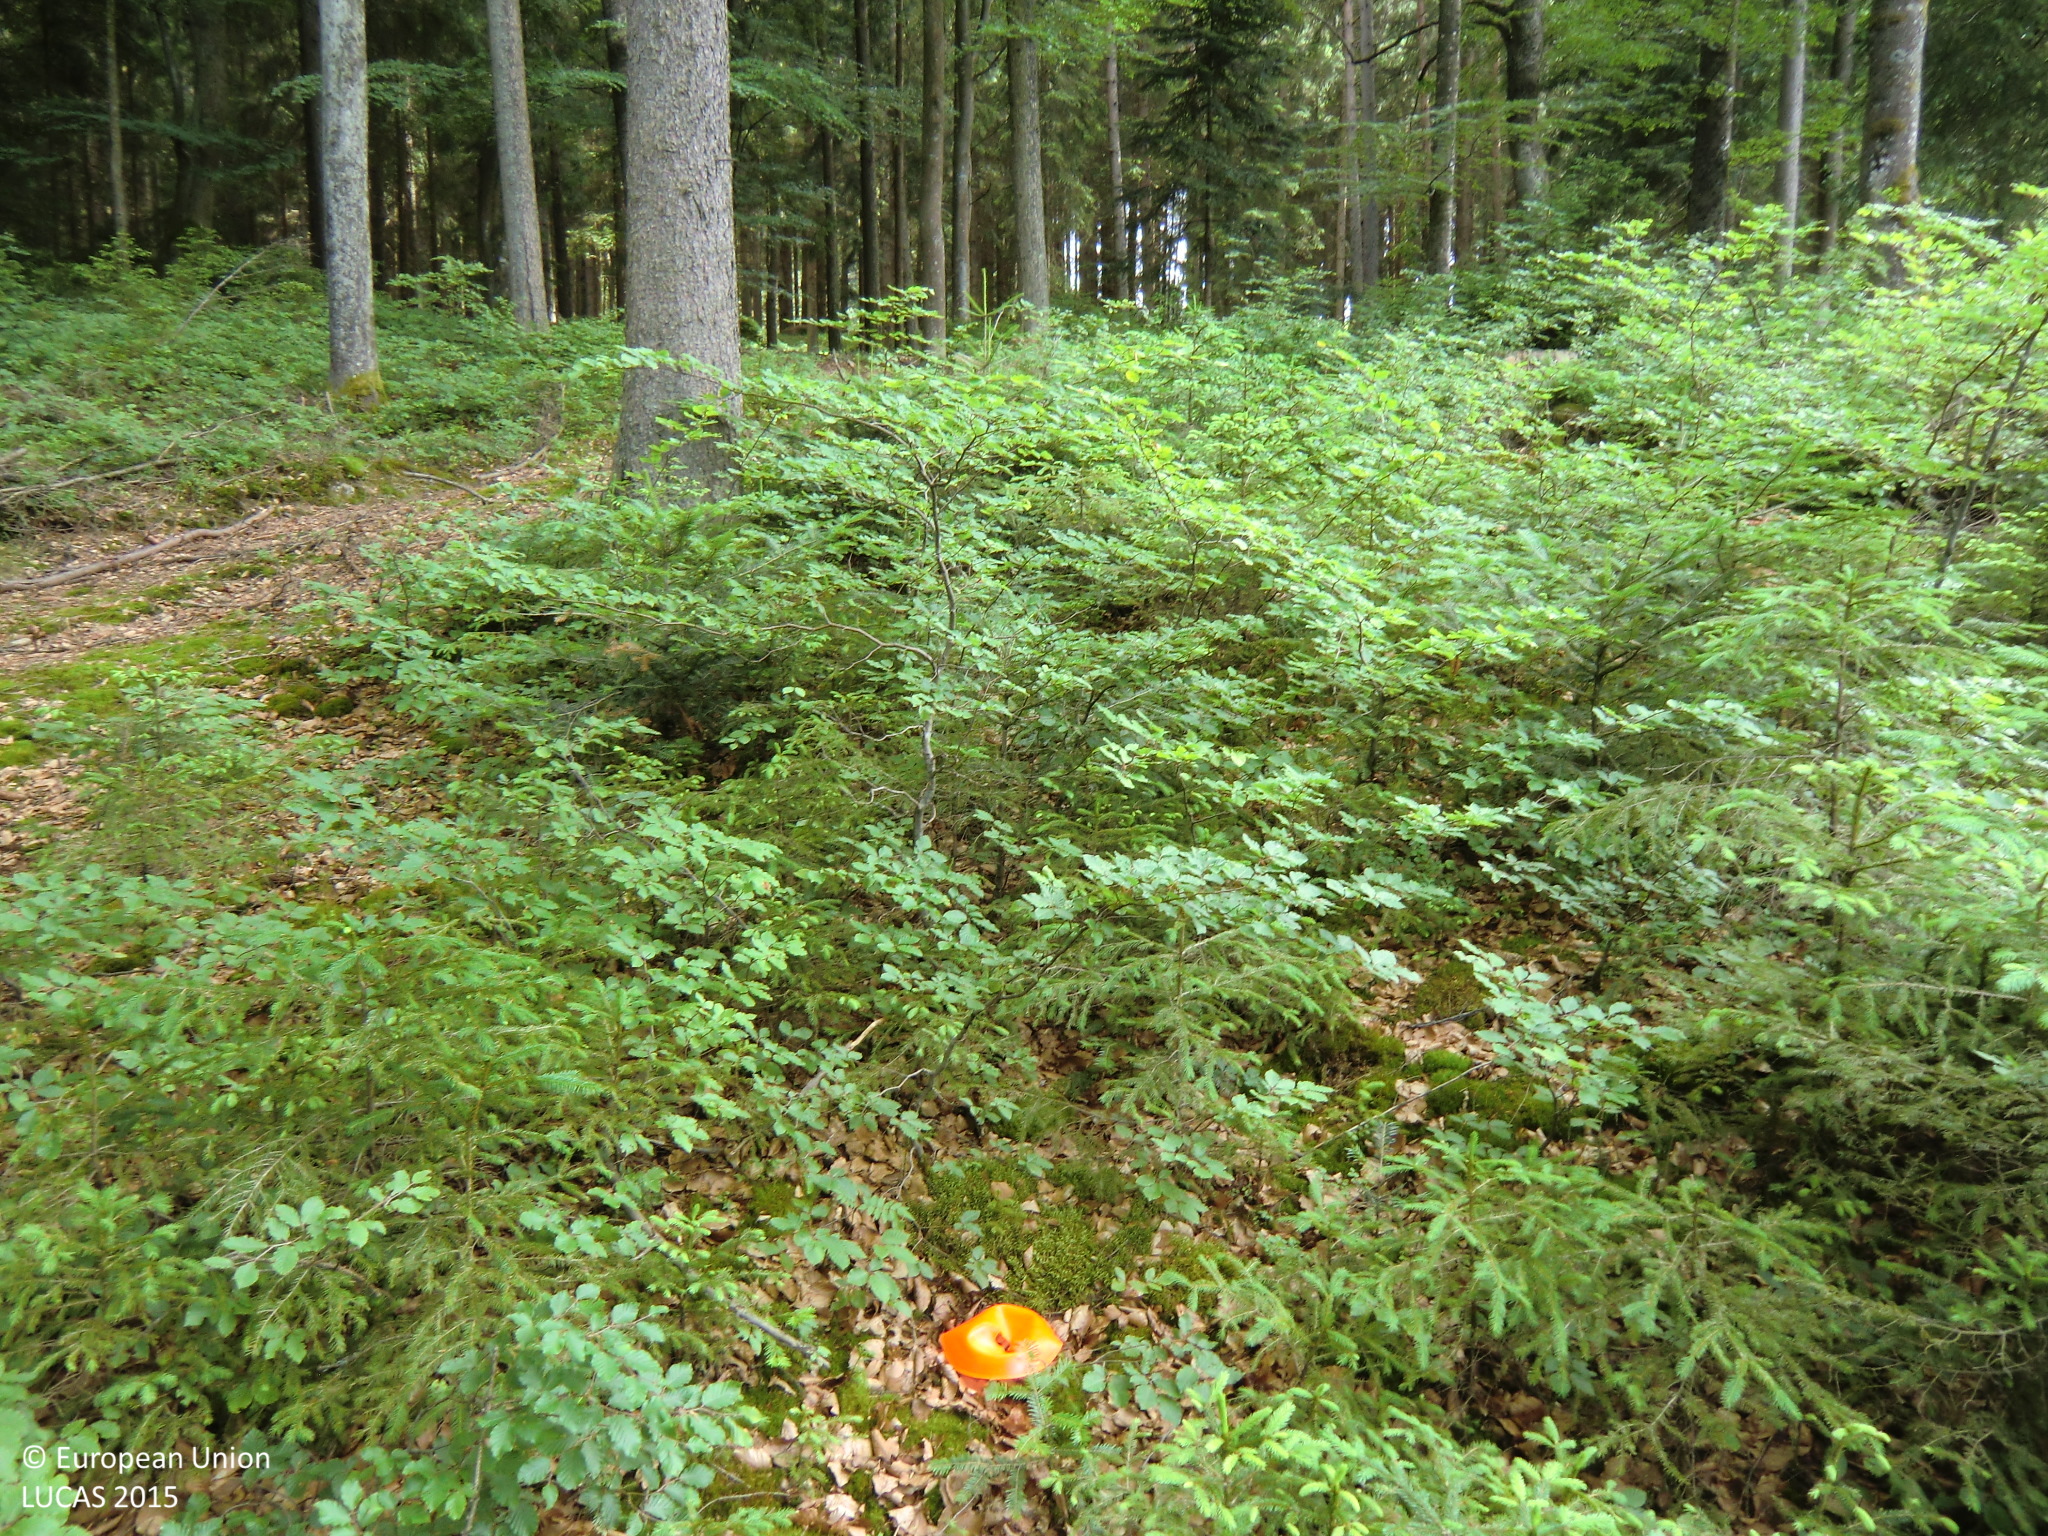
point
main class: Woodland
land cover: Spruce dominated mixed woodland
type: hemiboreal forest and nemoral coniferous forest and mixed broadleaved-coniferous forest
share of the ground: > 75 %
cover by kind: coniferous forest trees 45 %, broadleaved forest trees 45 %, herbaceous plants 5 %, unconsolidated bare surface 5 %
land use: Forestry
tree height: > 5 m
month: June
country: AT
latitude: 48.4531
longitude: 14.9909
